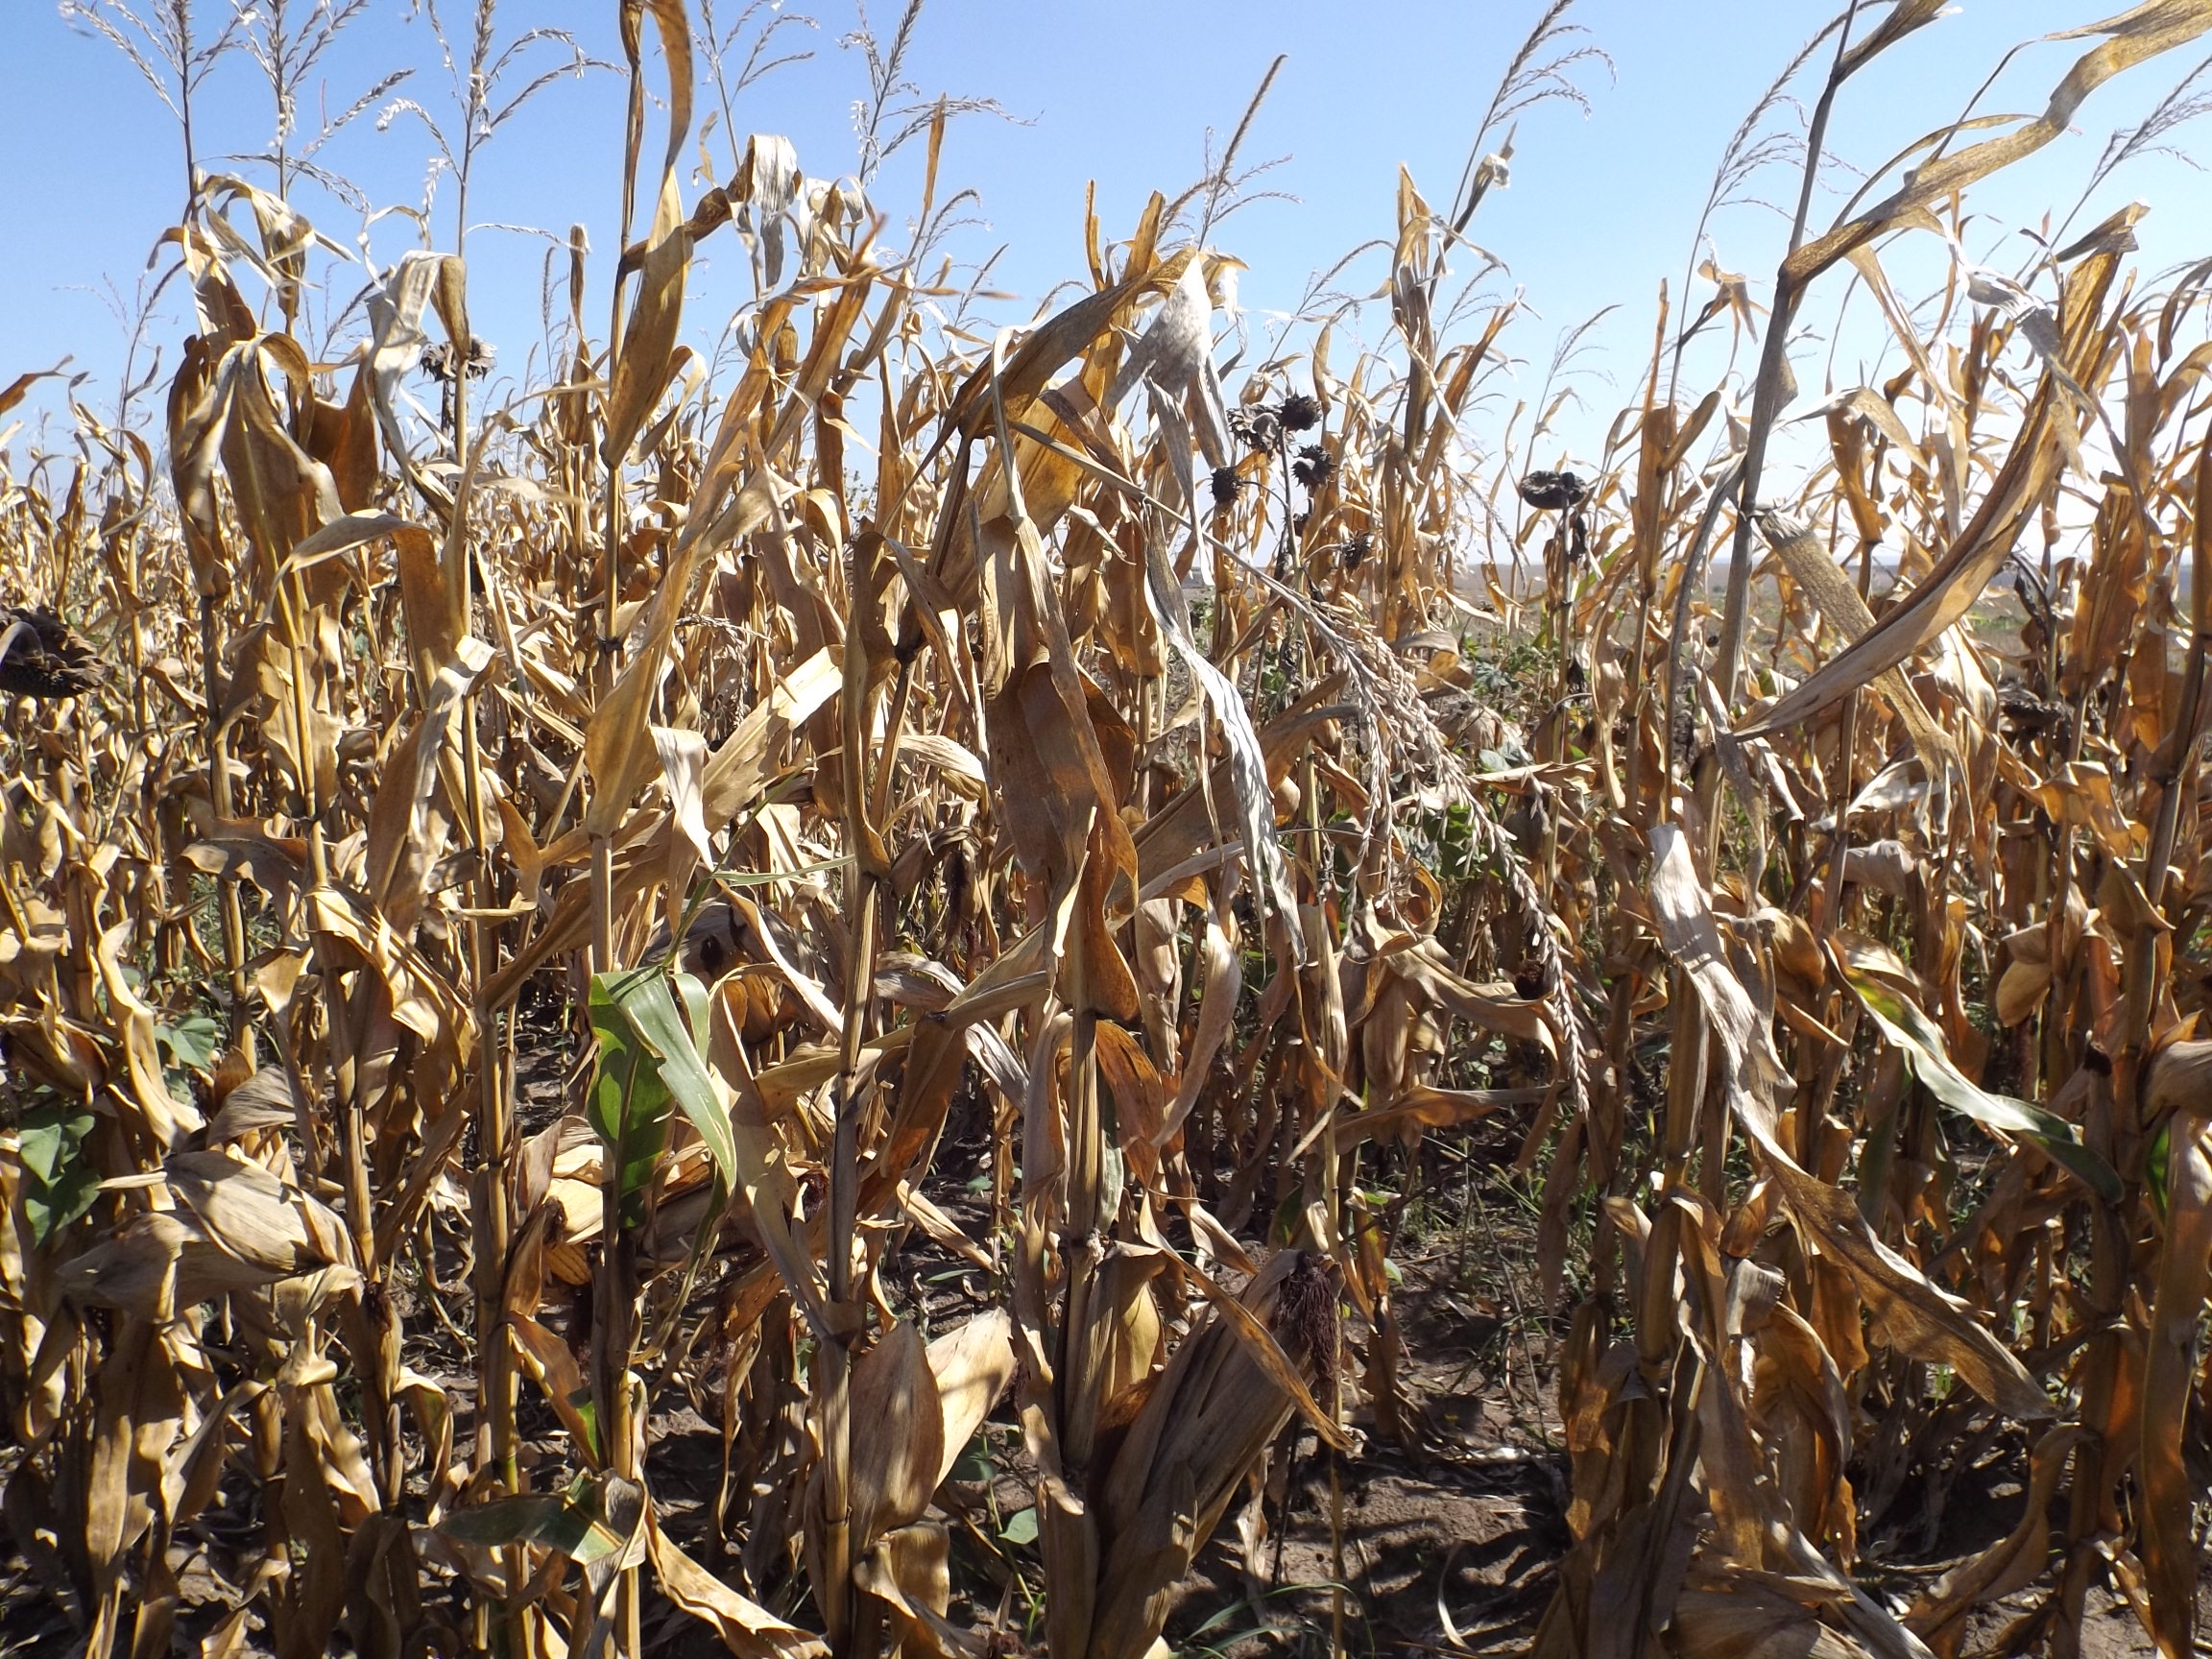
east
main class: Cropland
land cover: Maize
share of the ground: > 75 %
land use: Agriculture (excluding fallow land and kitchen gardens)
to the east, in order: Maize; Common wheat; Tracks; Common wheat; Grassland with sparse tree/shrub cover; Grassland without tree/shrub cover
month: September
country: BG
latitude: 43.9389
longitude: 26.4918
